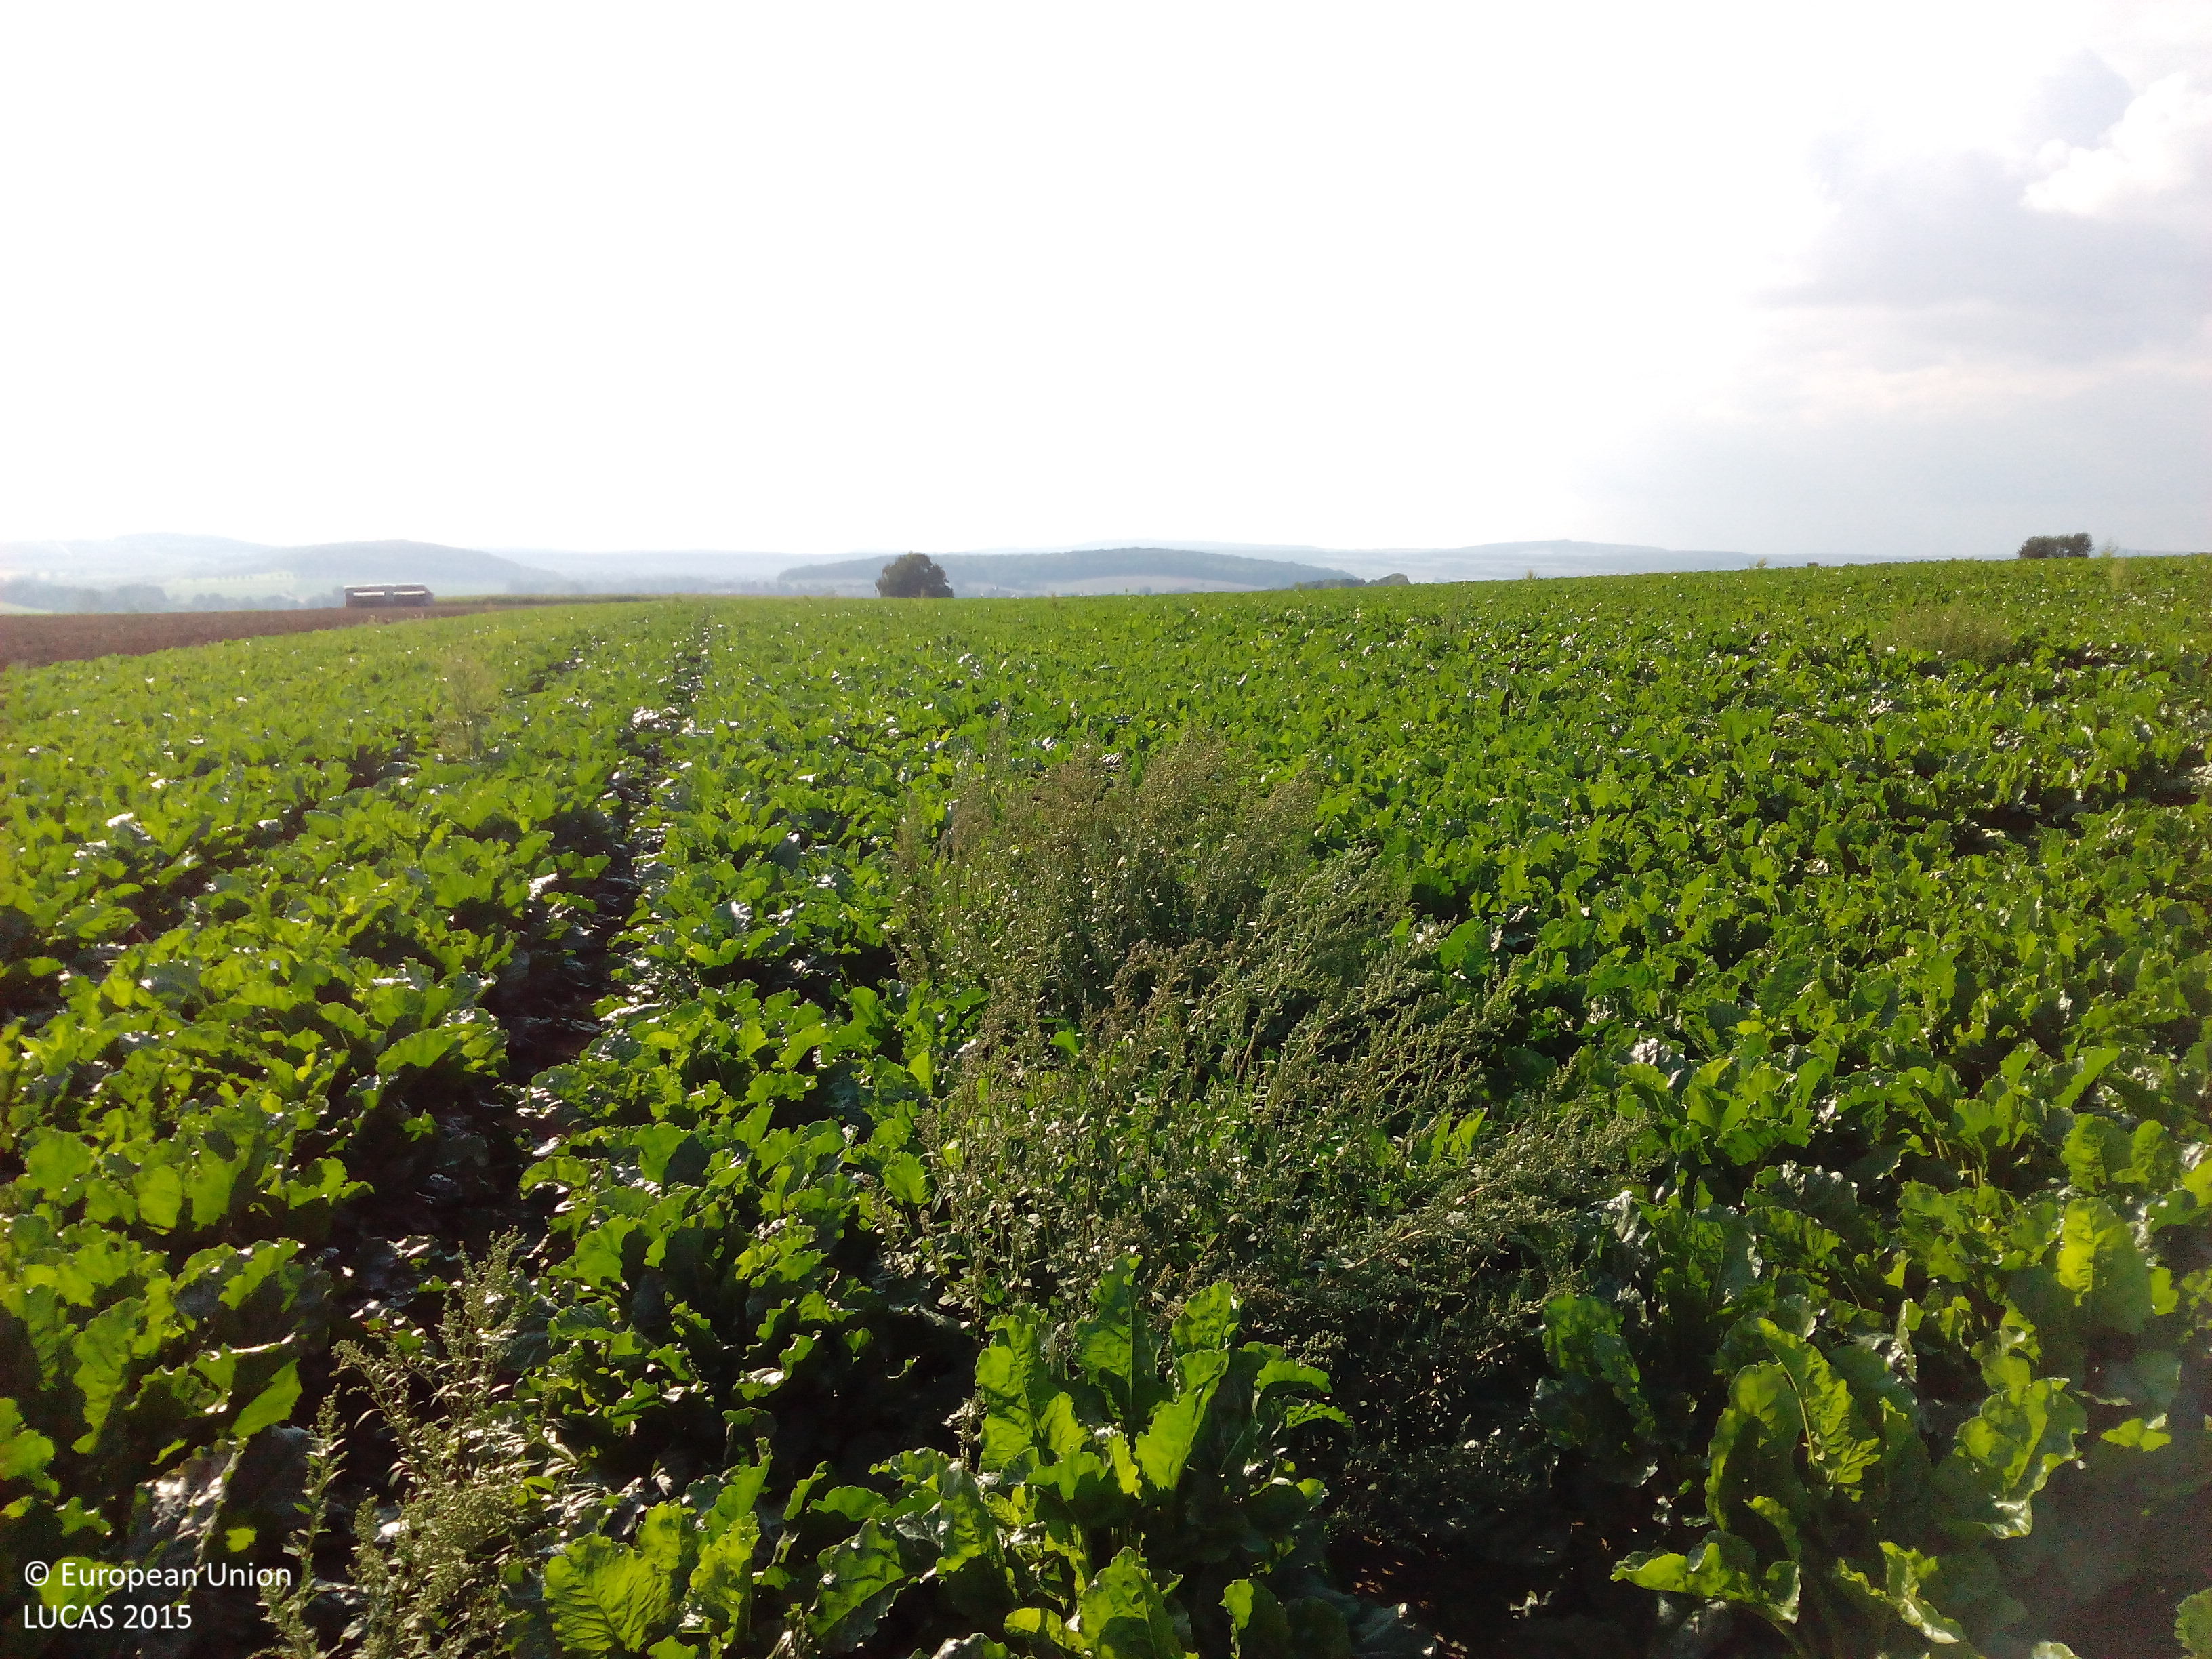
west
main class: Cropland
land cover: Sugar beet
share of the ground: > 75 %
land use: Agriculture (excluding fallow land and kitchen gardens)
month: September
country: DE
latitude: 51.4607
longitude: 9.9568
